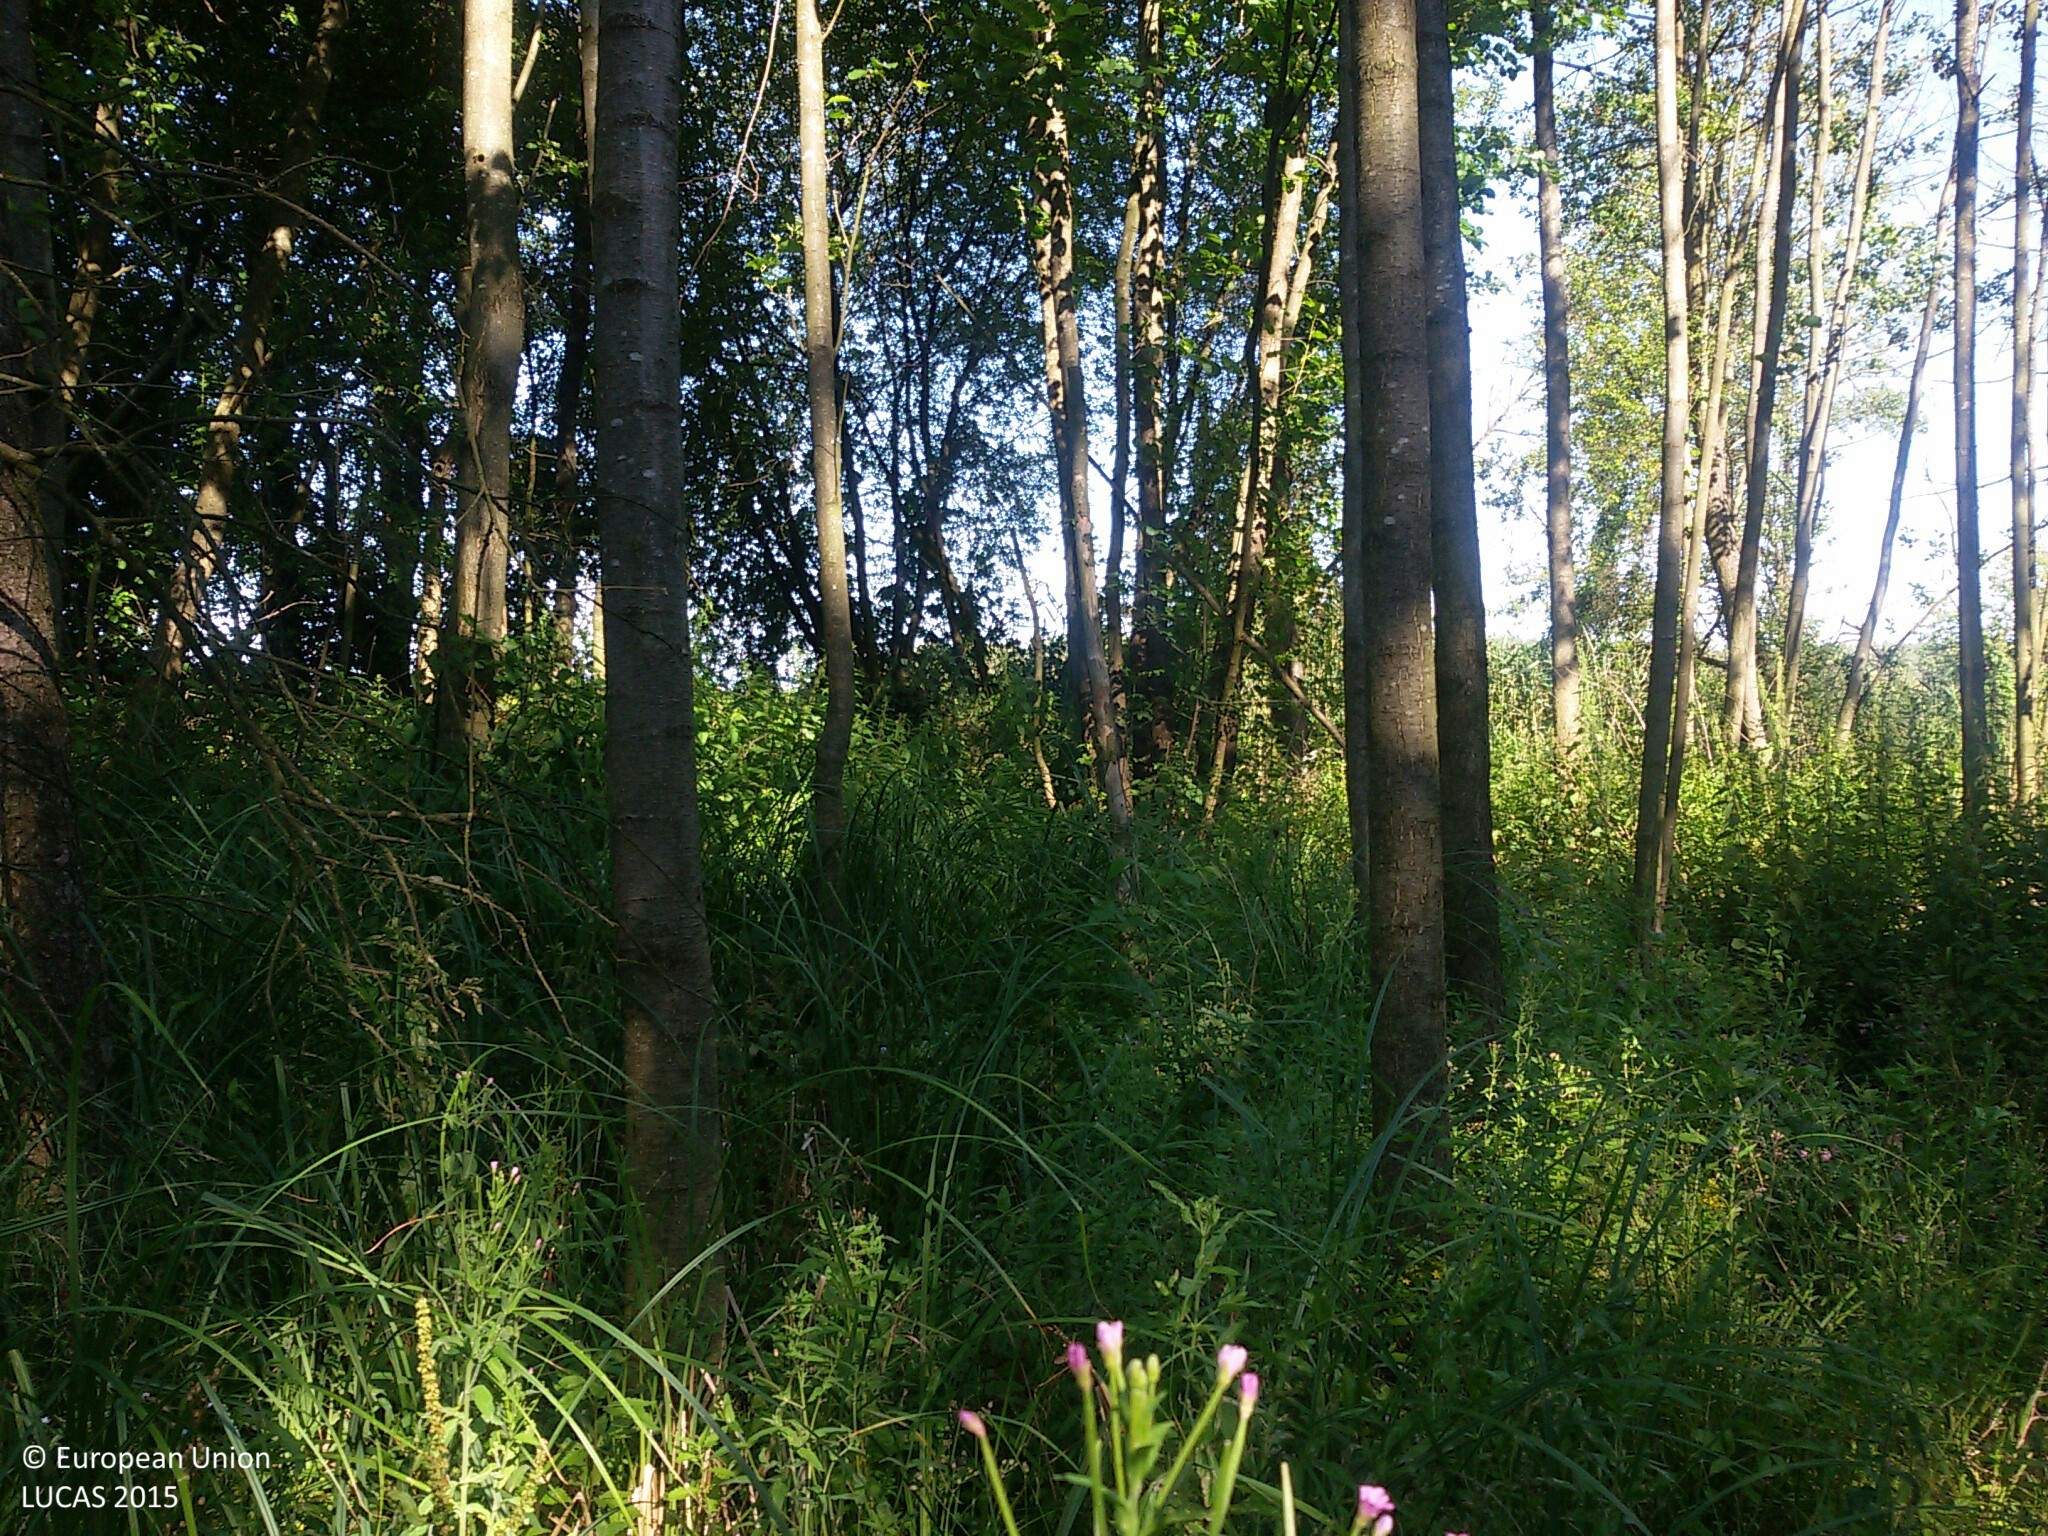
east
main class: Woodland
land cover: Broadleaved woodland
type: mesophytic deciduous forest
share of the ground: > 75 %
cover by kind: broadleaved forest trees 85 %, shrubs 15 %
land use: Forestry
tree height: > 5 m
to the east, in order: Broadleaved woodland; Rivers and streams; Broadleaved woodland; Grassland without tree/shrub cover
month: July
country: PL
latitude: 52.9043
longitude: 21.3329
